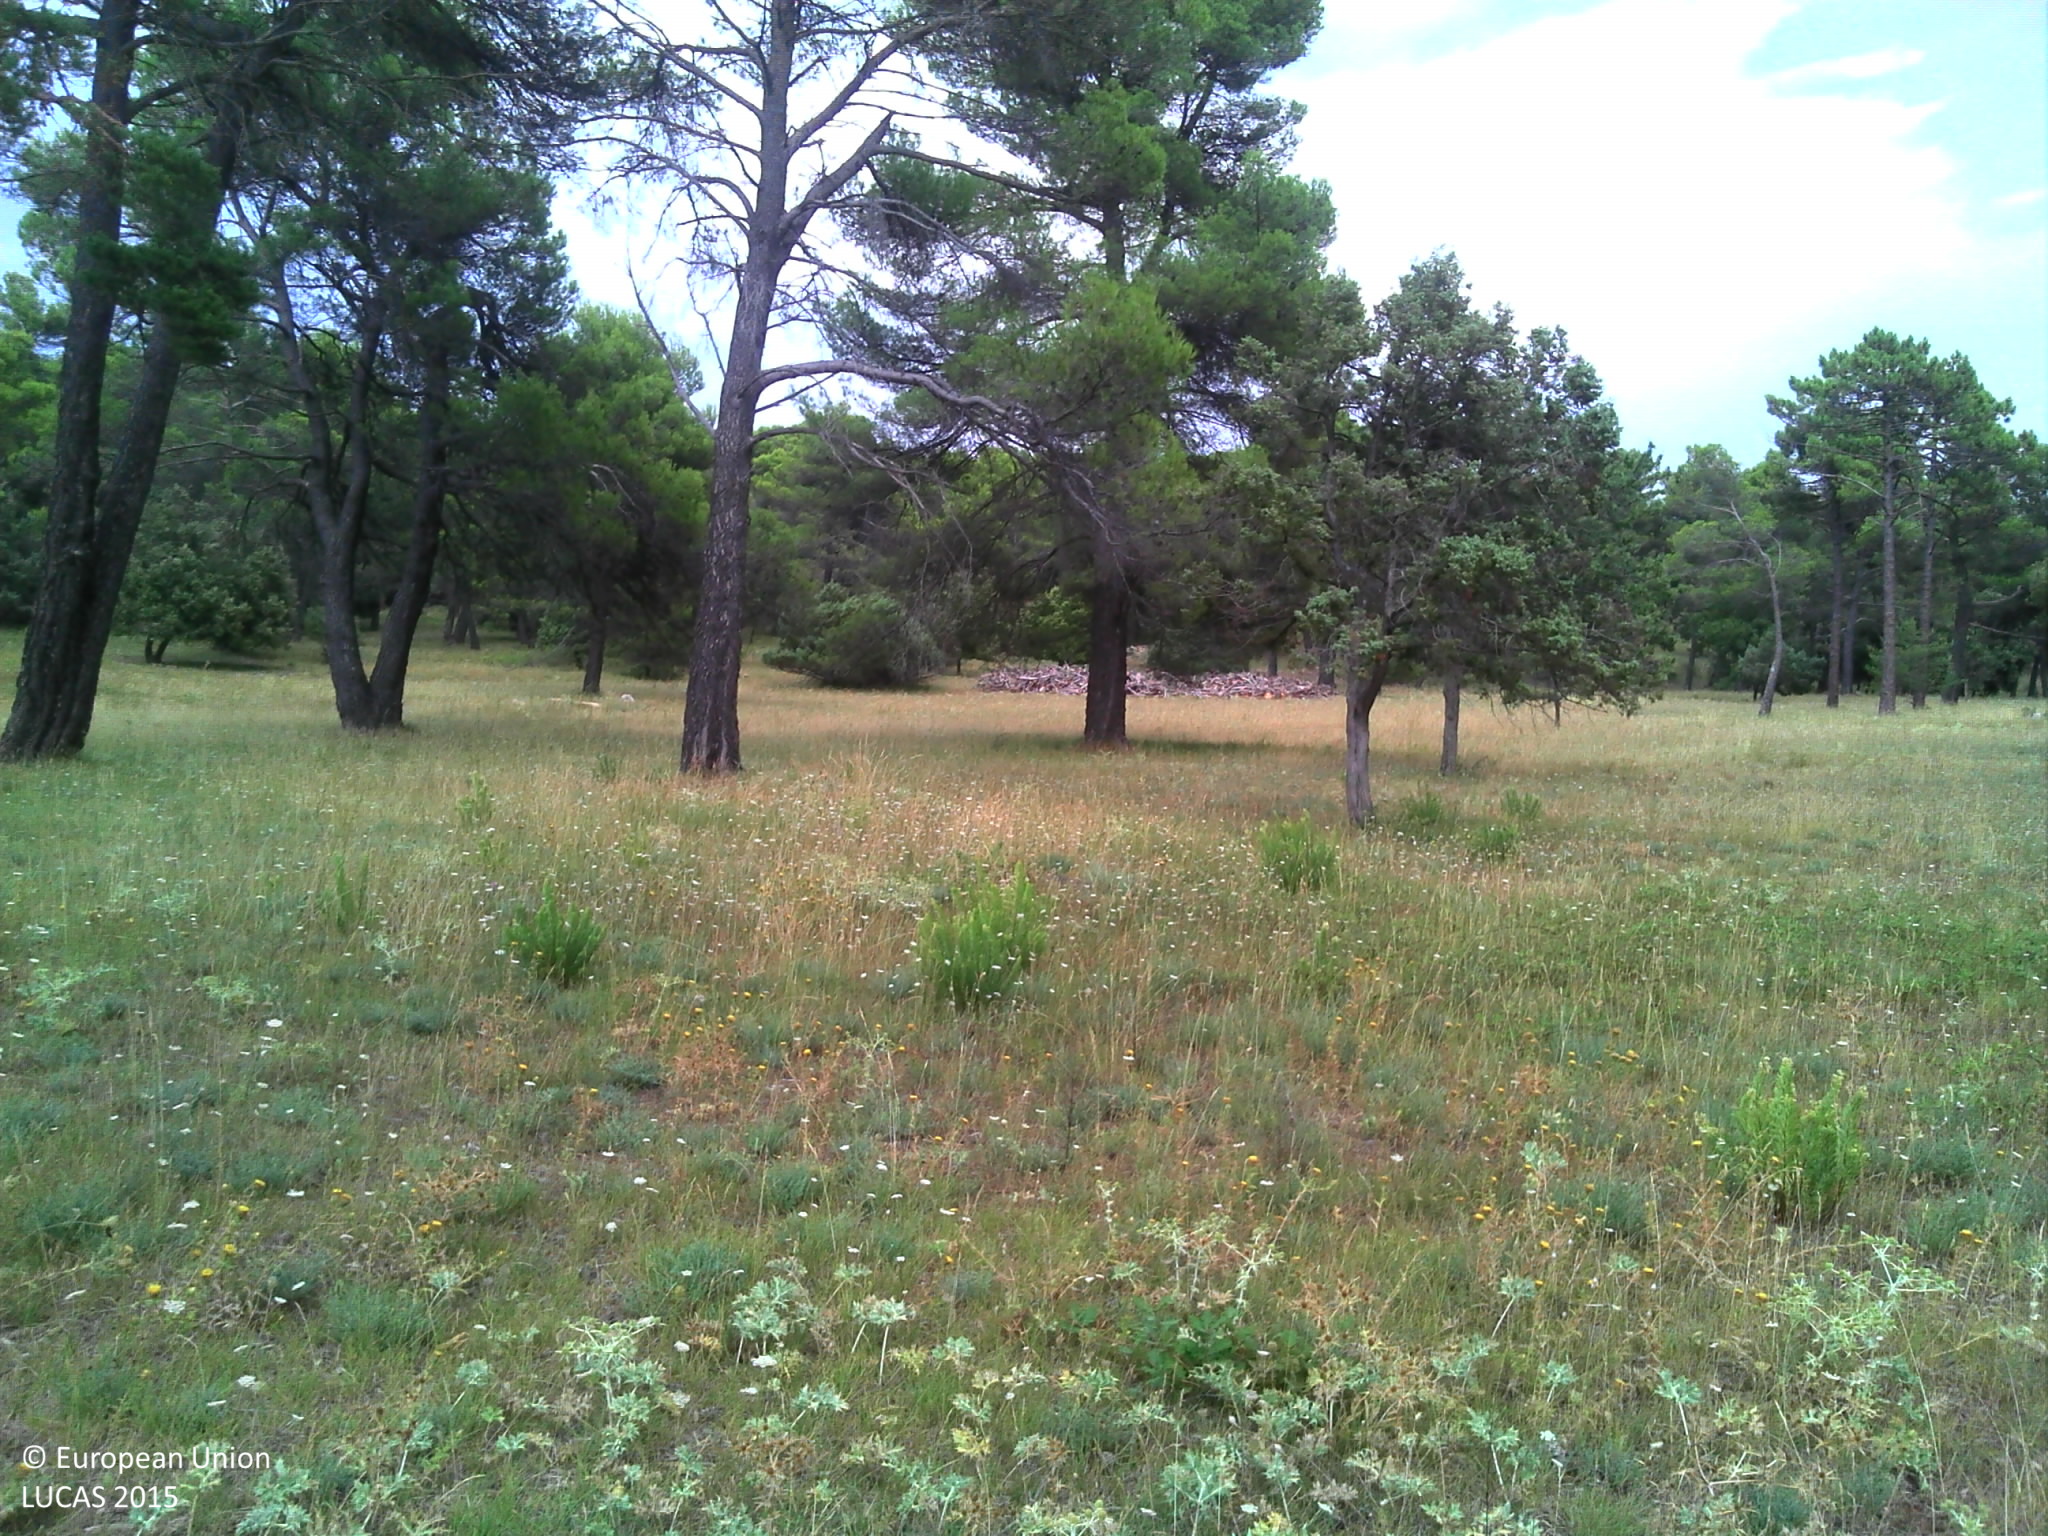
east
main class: Grassland
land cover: Grassland with sparse tree/shrub cover
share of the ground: > 75 %
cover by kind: herbaceous plants 95 %, coniferous forest trees 5 %
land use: Amenities, museums, leisure
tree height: > 5 m
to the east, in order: Grassland with sparse tree/shrub cover; Tracks; Fences; Broadleaved woodland
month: August
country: FR
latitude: 43.5814
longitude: 6.3305
